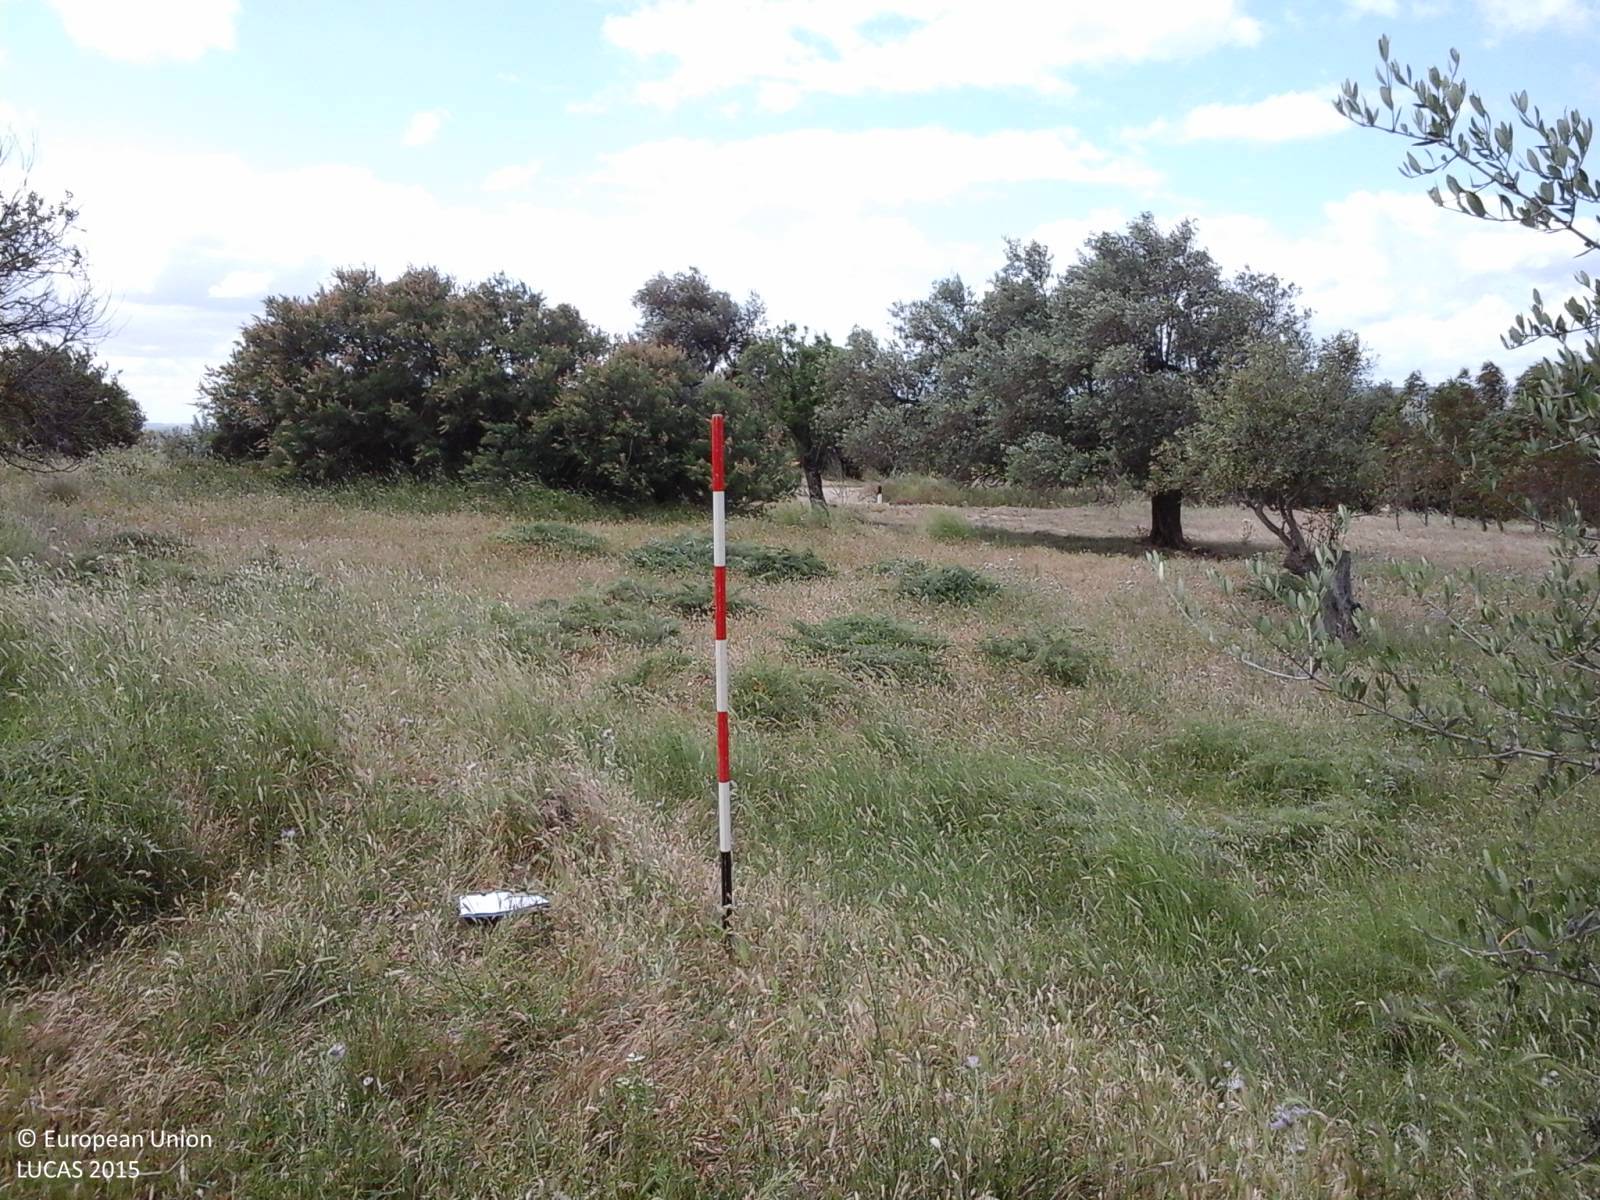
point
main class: Grassland
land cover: Spontaneously vegetated surfaces
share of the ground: > 75 %
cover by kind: herbaceous plants 95 %, shrubs 5 %
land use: Agriculture (excluding fallow land and kitchen gardens)
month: May
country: IT
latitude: 39.7541
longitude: 8.8975
